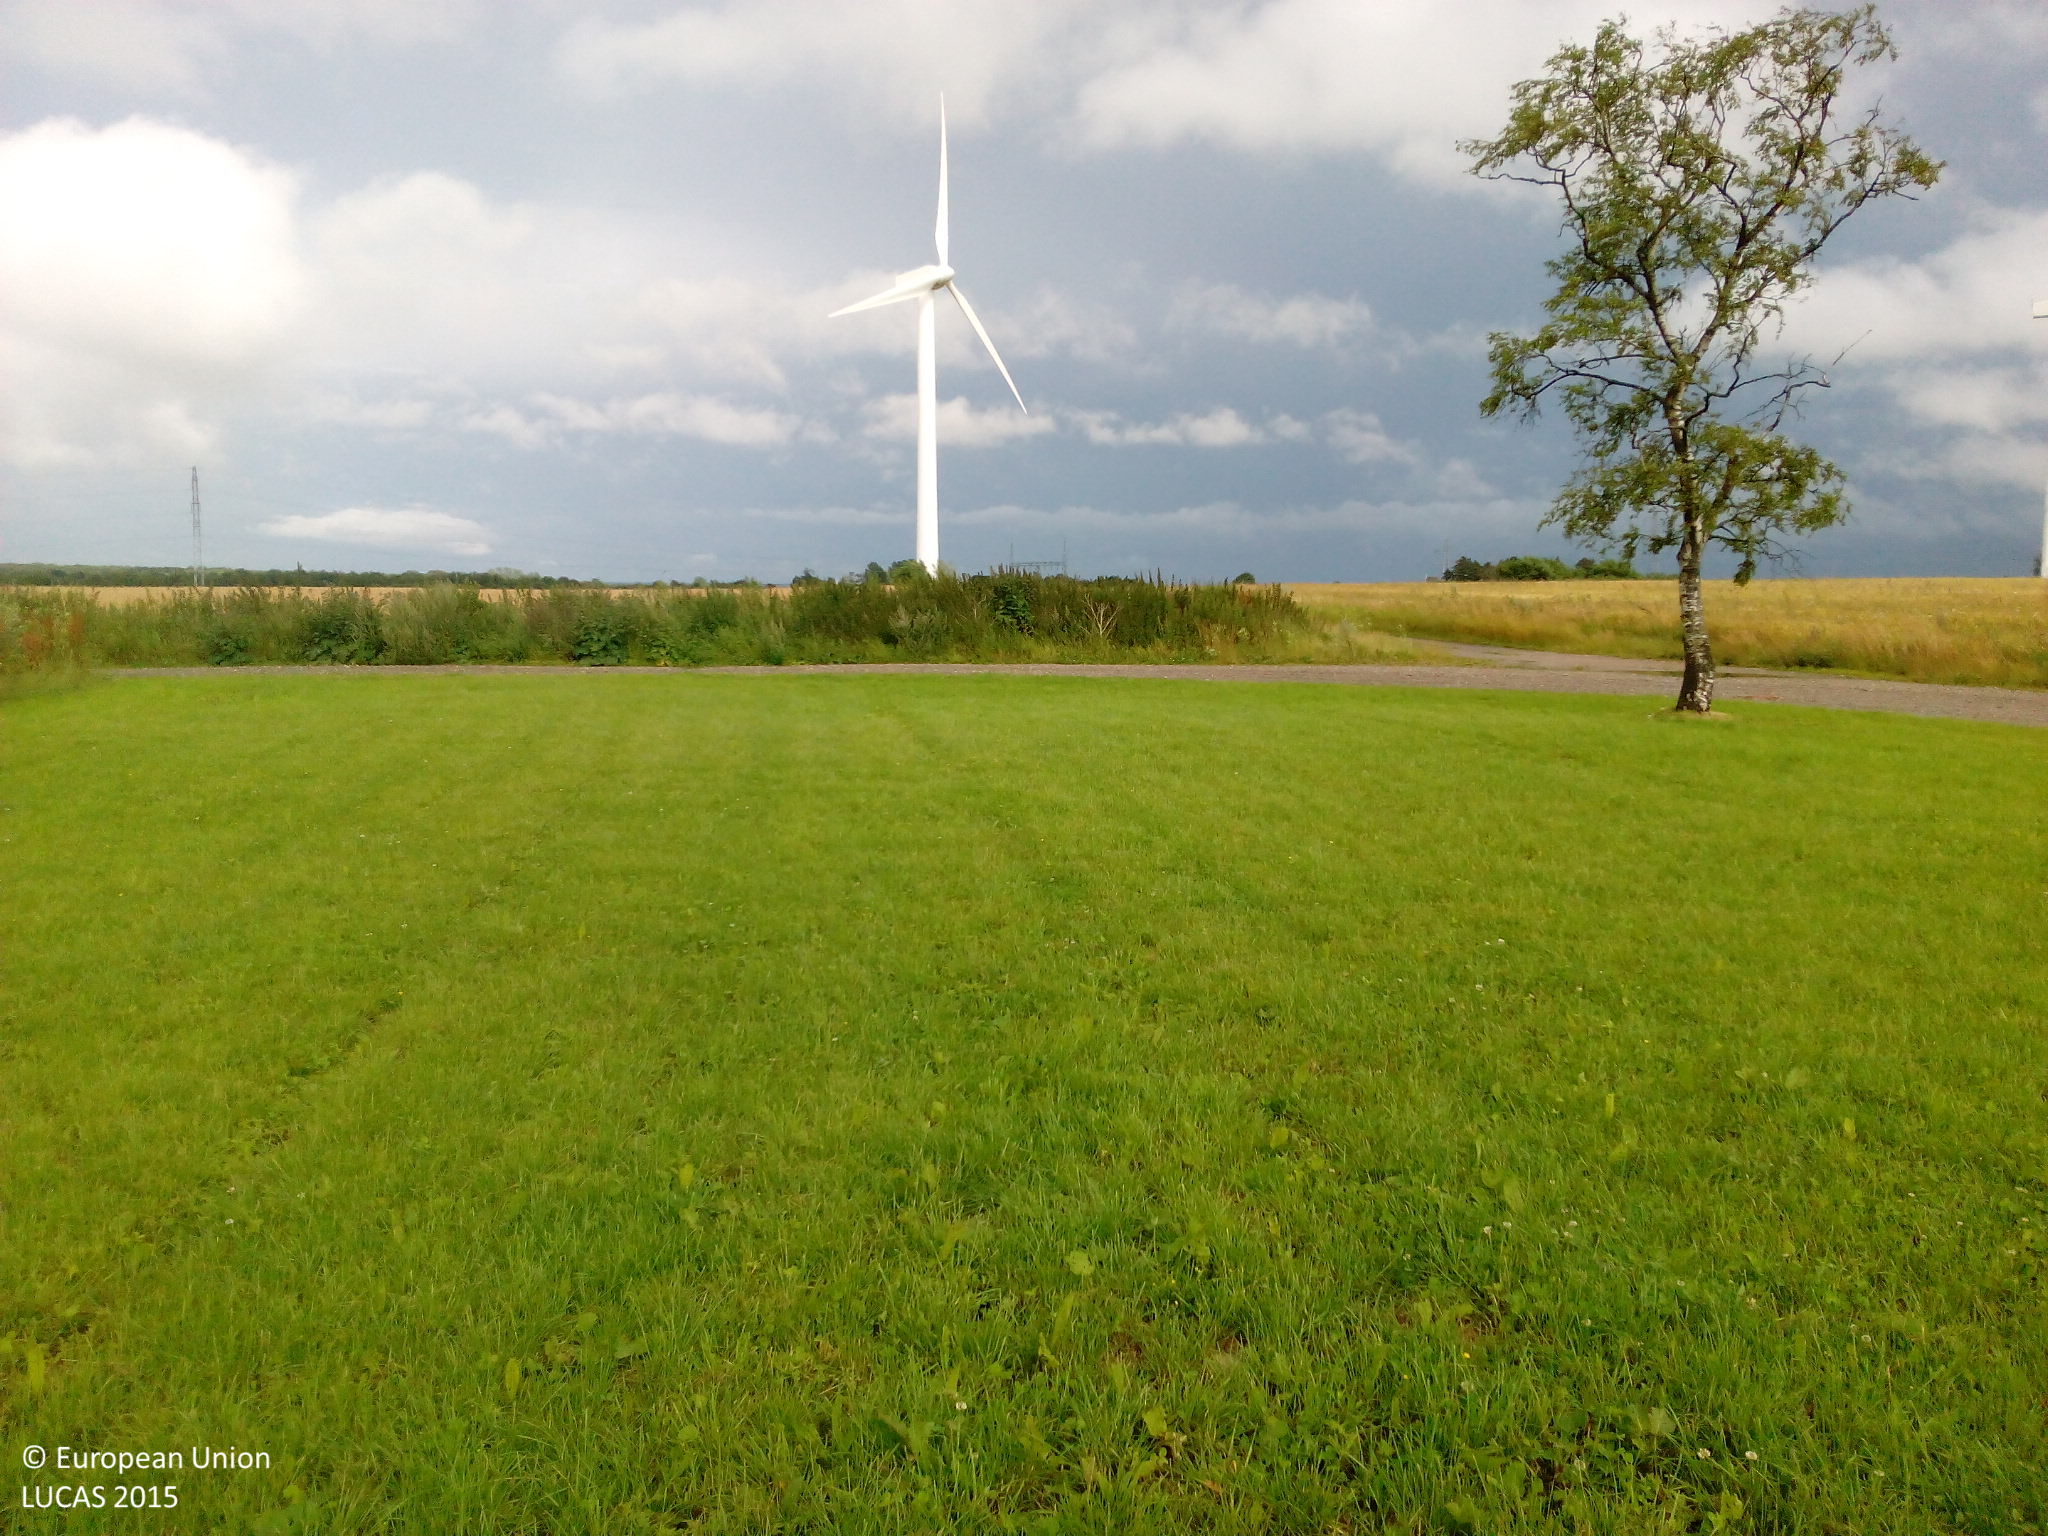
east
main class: Grassland
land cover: Grassland without tree/shrub cover
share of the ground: > 75 %
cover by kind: herbaceous plants 100 %
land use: Agriculture (excluding fallow land and kitchen gardens)
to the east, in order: Grassland without tree/shrub cover; Tracks; Spontaneously vegetated surfaces; Rye; Grassland without tree/shrub cover; Artificial constructions in urban areas; Grass margins; Fences; Other leguminous and mixtures for fodder
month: July
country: DK
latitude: 55.8994
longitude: 12.1890
